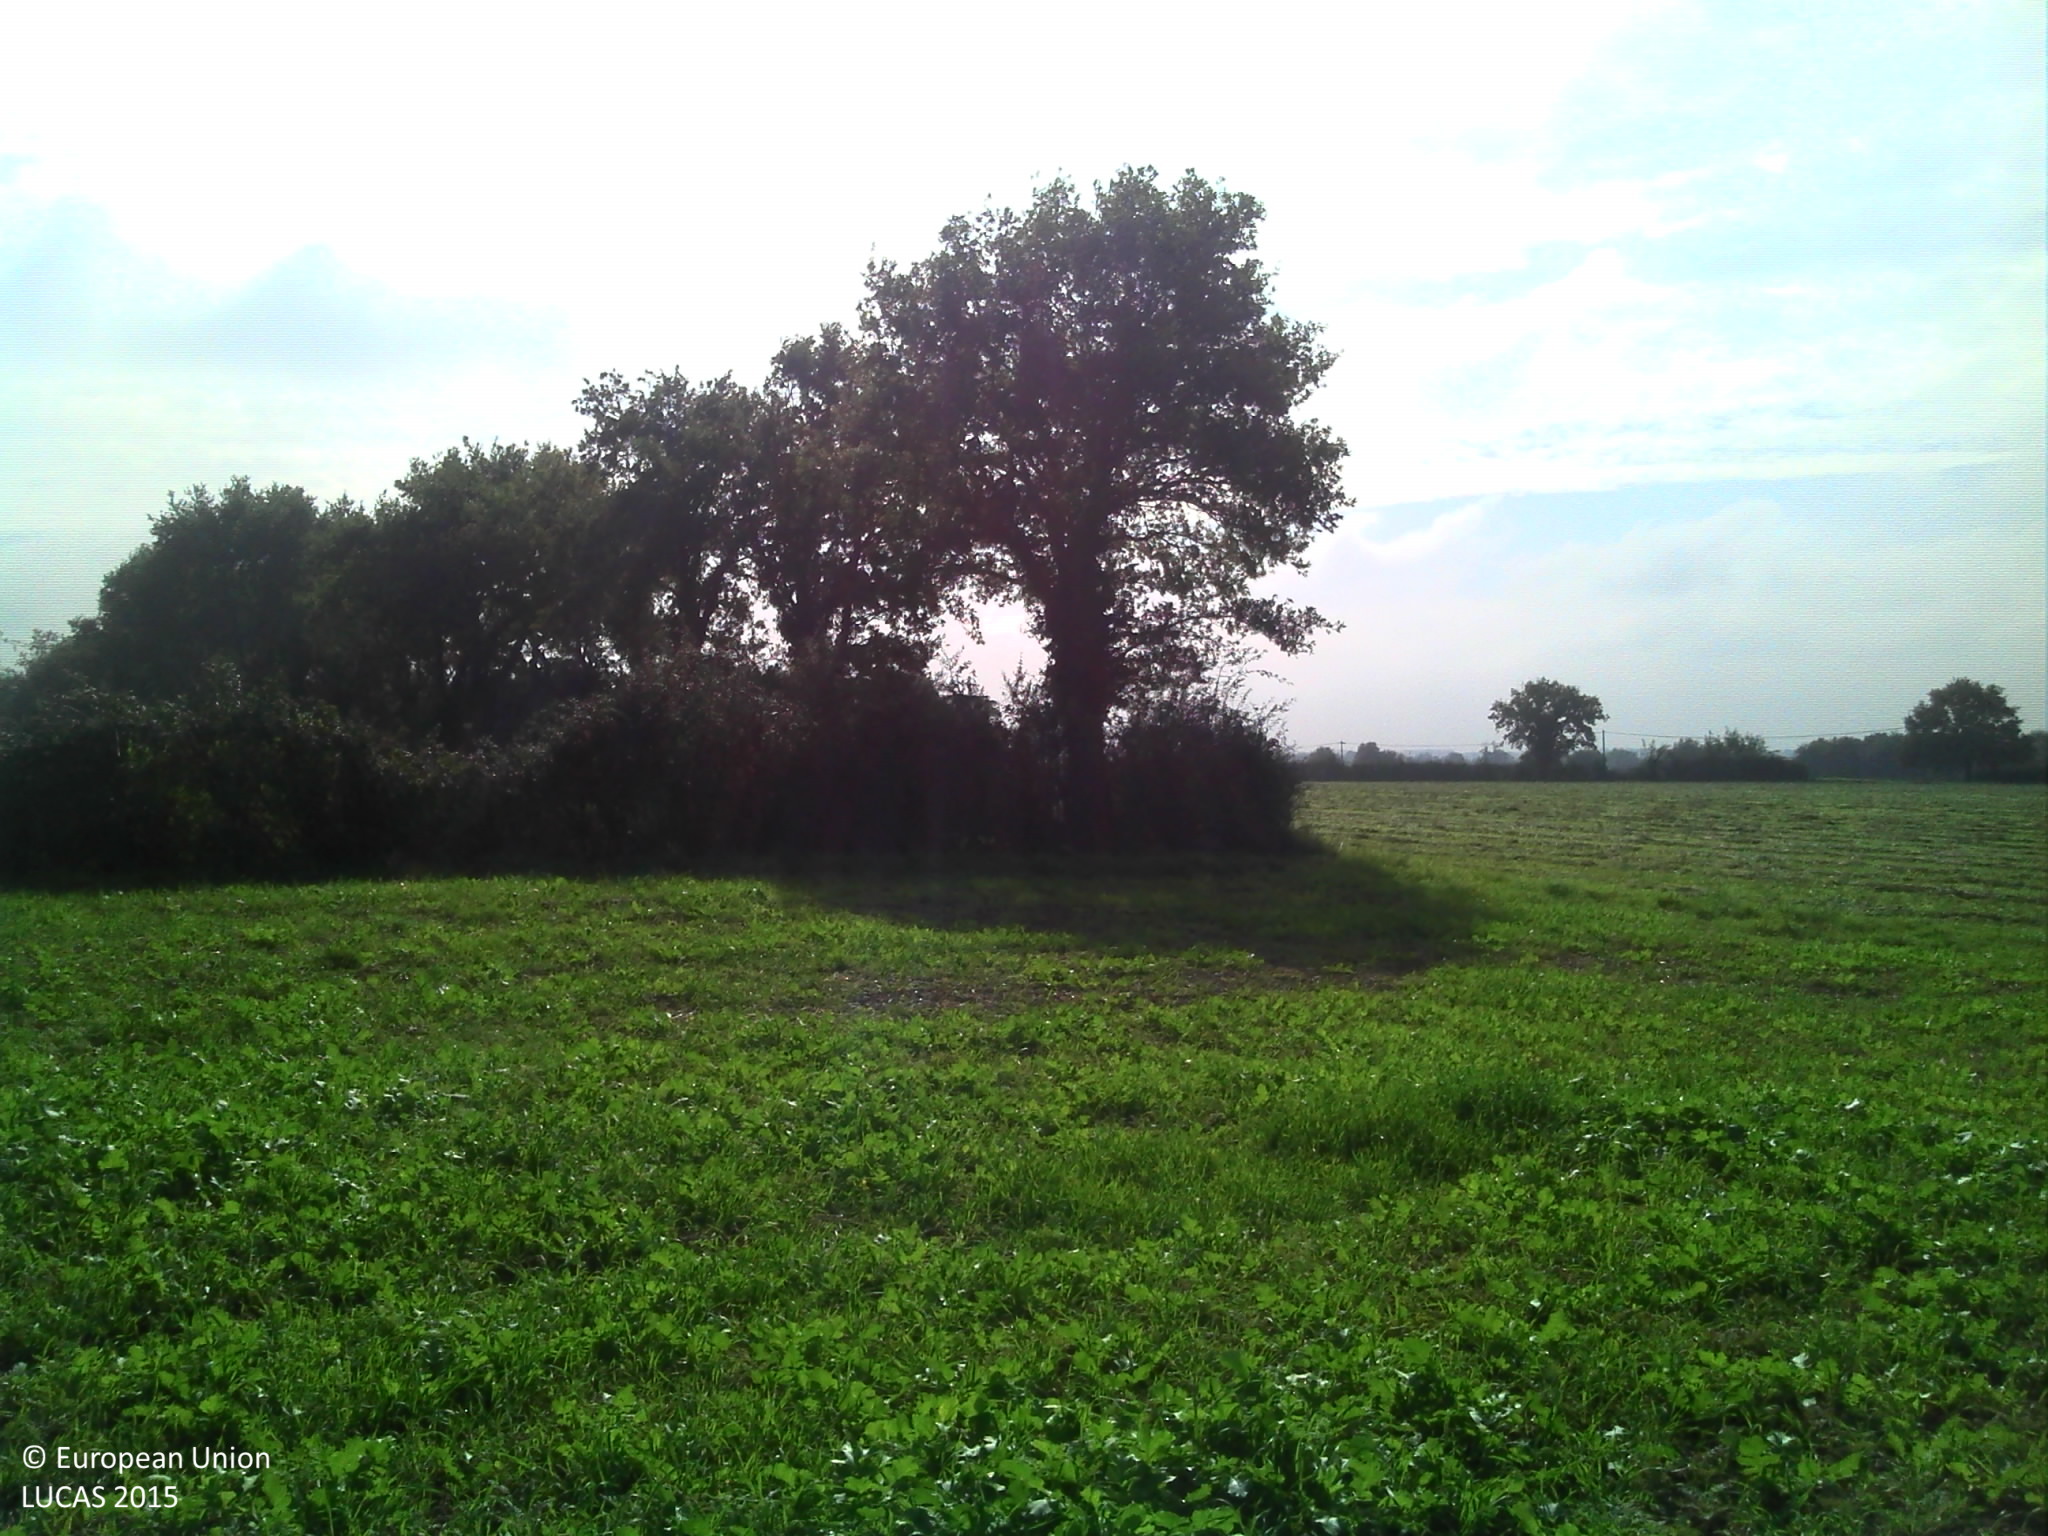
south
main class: Grassland
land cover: Spontaneously vegetated surfaces
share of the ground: > 75 %
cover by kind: herbaceous plants 95 %, unconsolidated bare surface 5 %
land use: Agriculture (excluding fallow land and kitchen gardens)
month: October
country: FR
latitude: 47.0262
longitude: -0.9148
